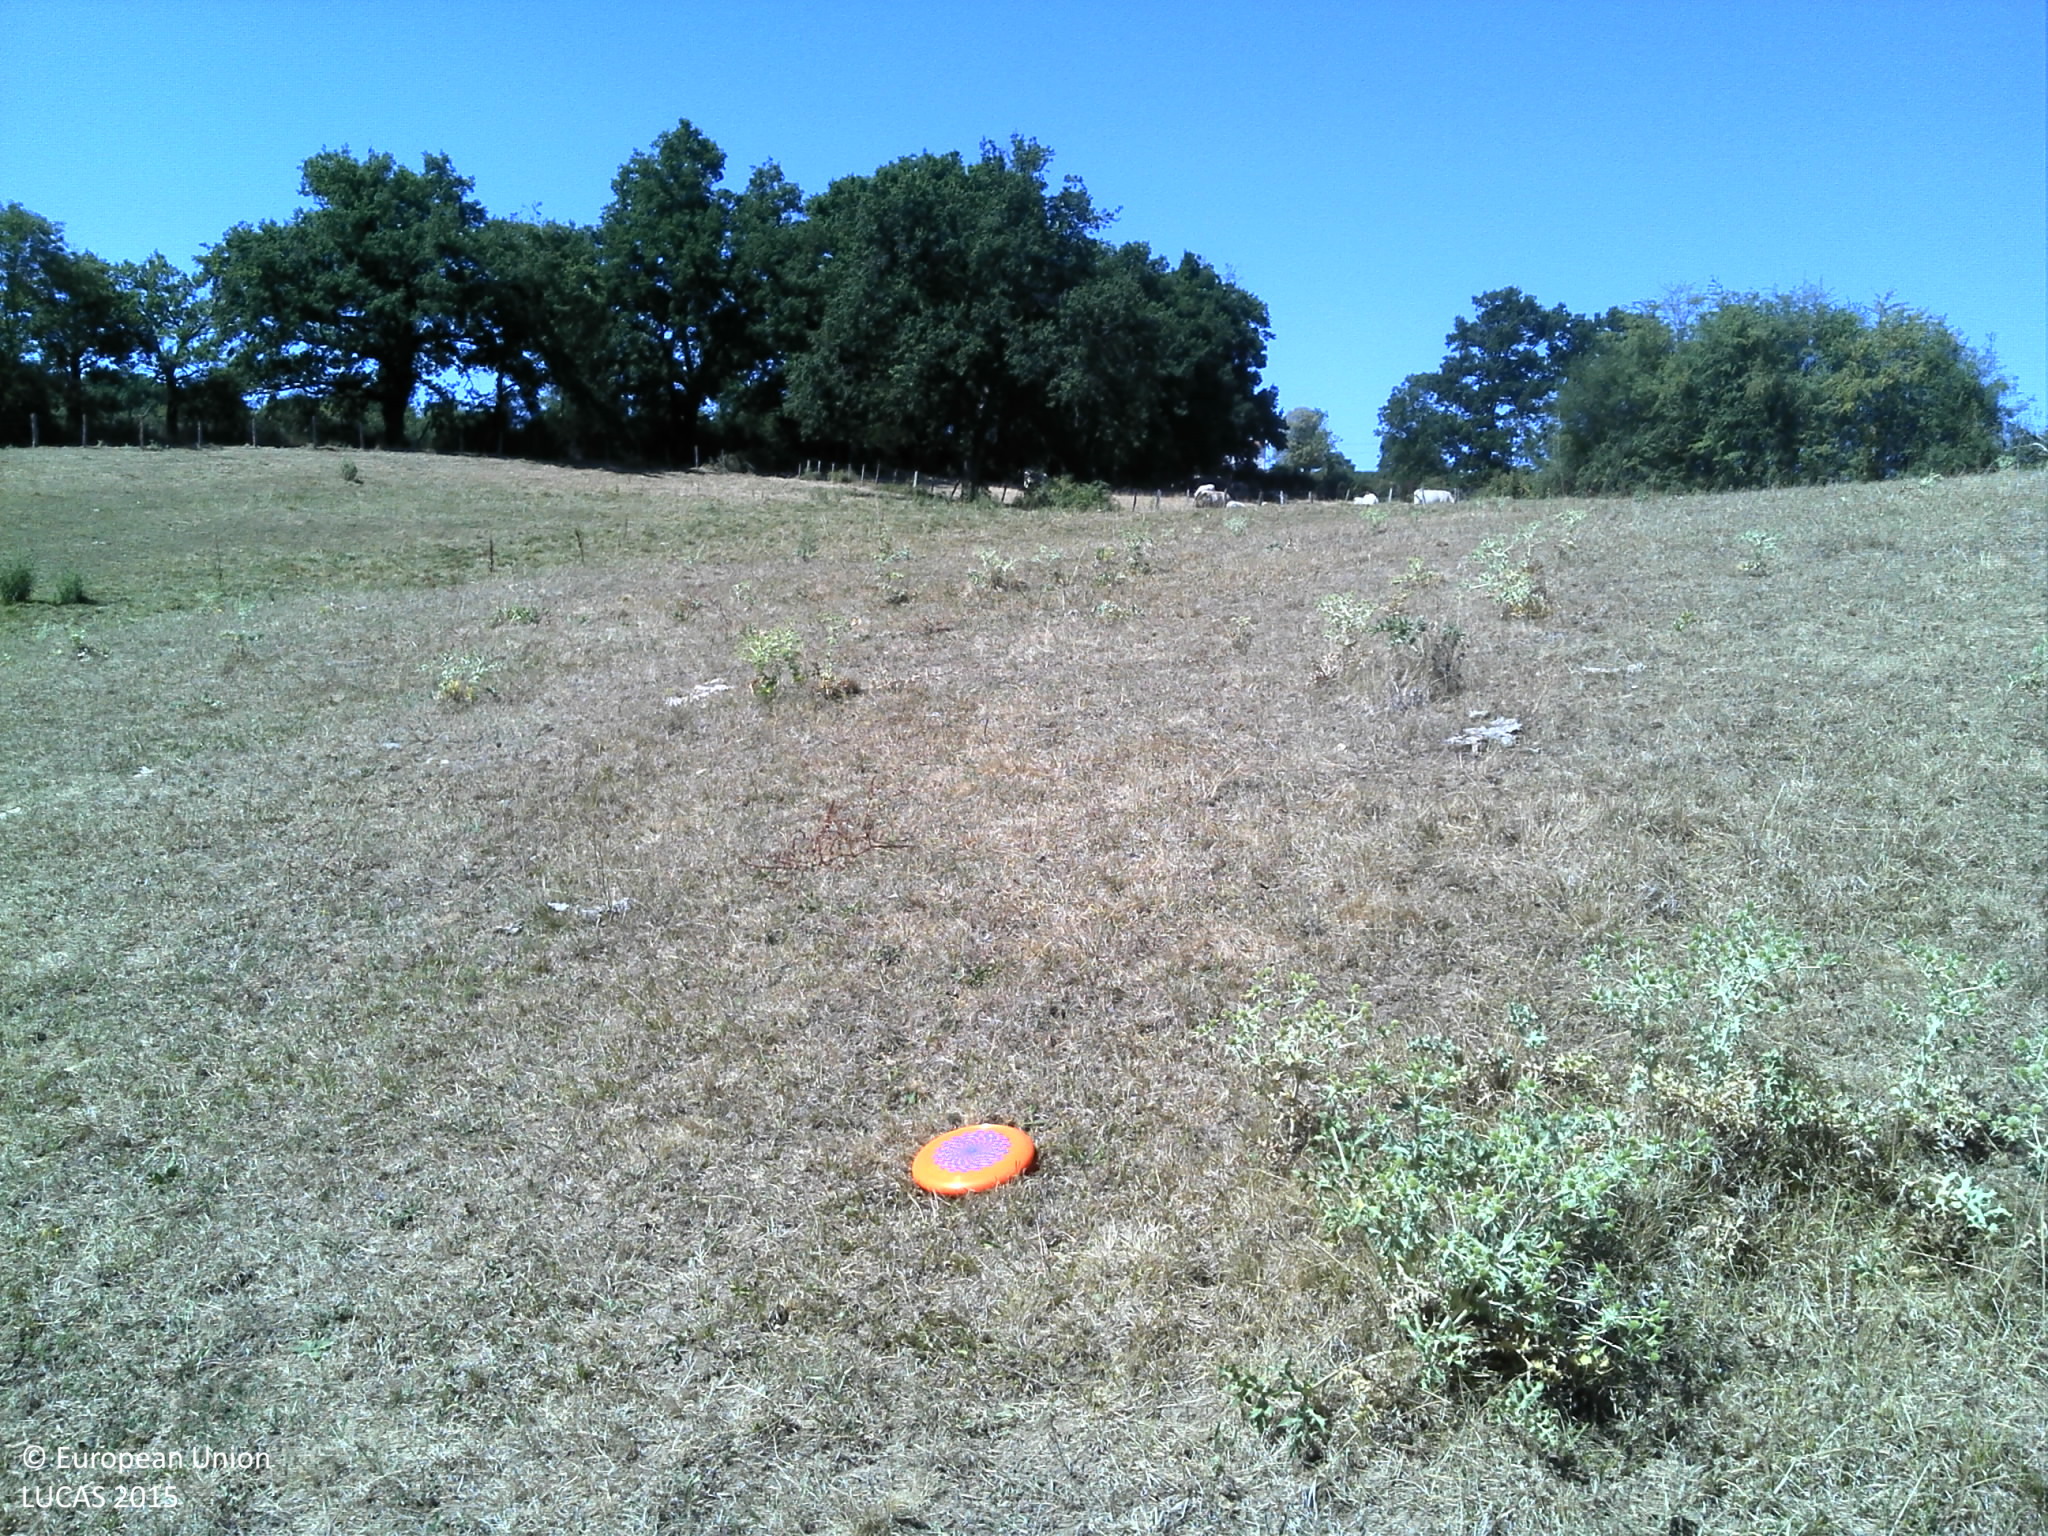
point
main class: Grassland
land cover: Grassland without tree/shrub cover
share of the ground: > 75 %
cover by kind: herbaceous plants 100 %
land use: Agriculture (excluding fallow land and kitchen gardens)
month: July
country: FR
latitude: 45.8792
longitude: 4.0623
